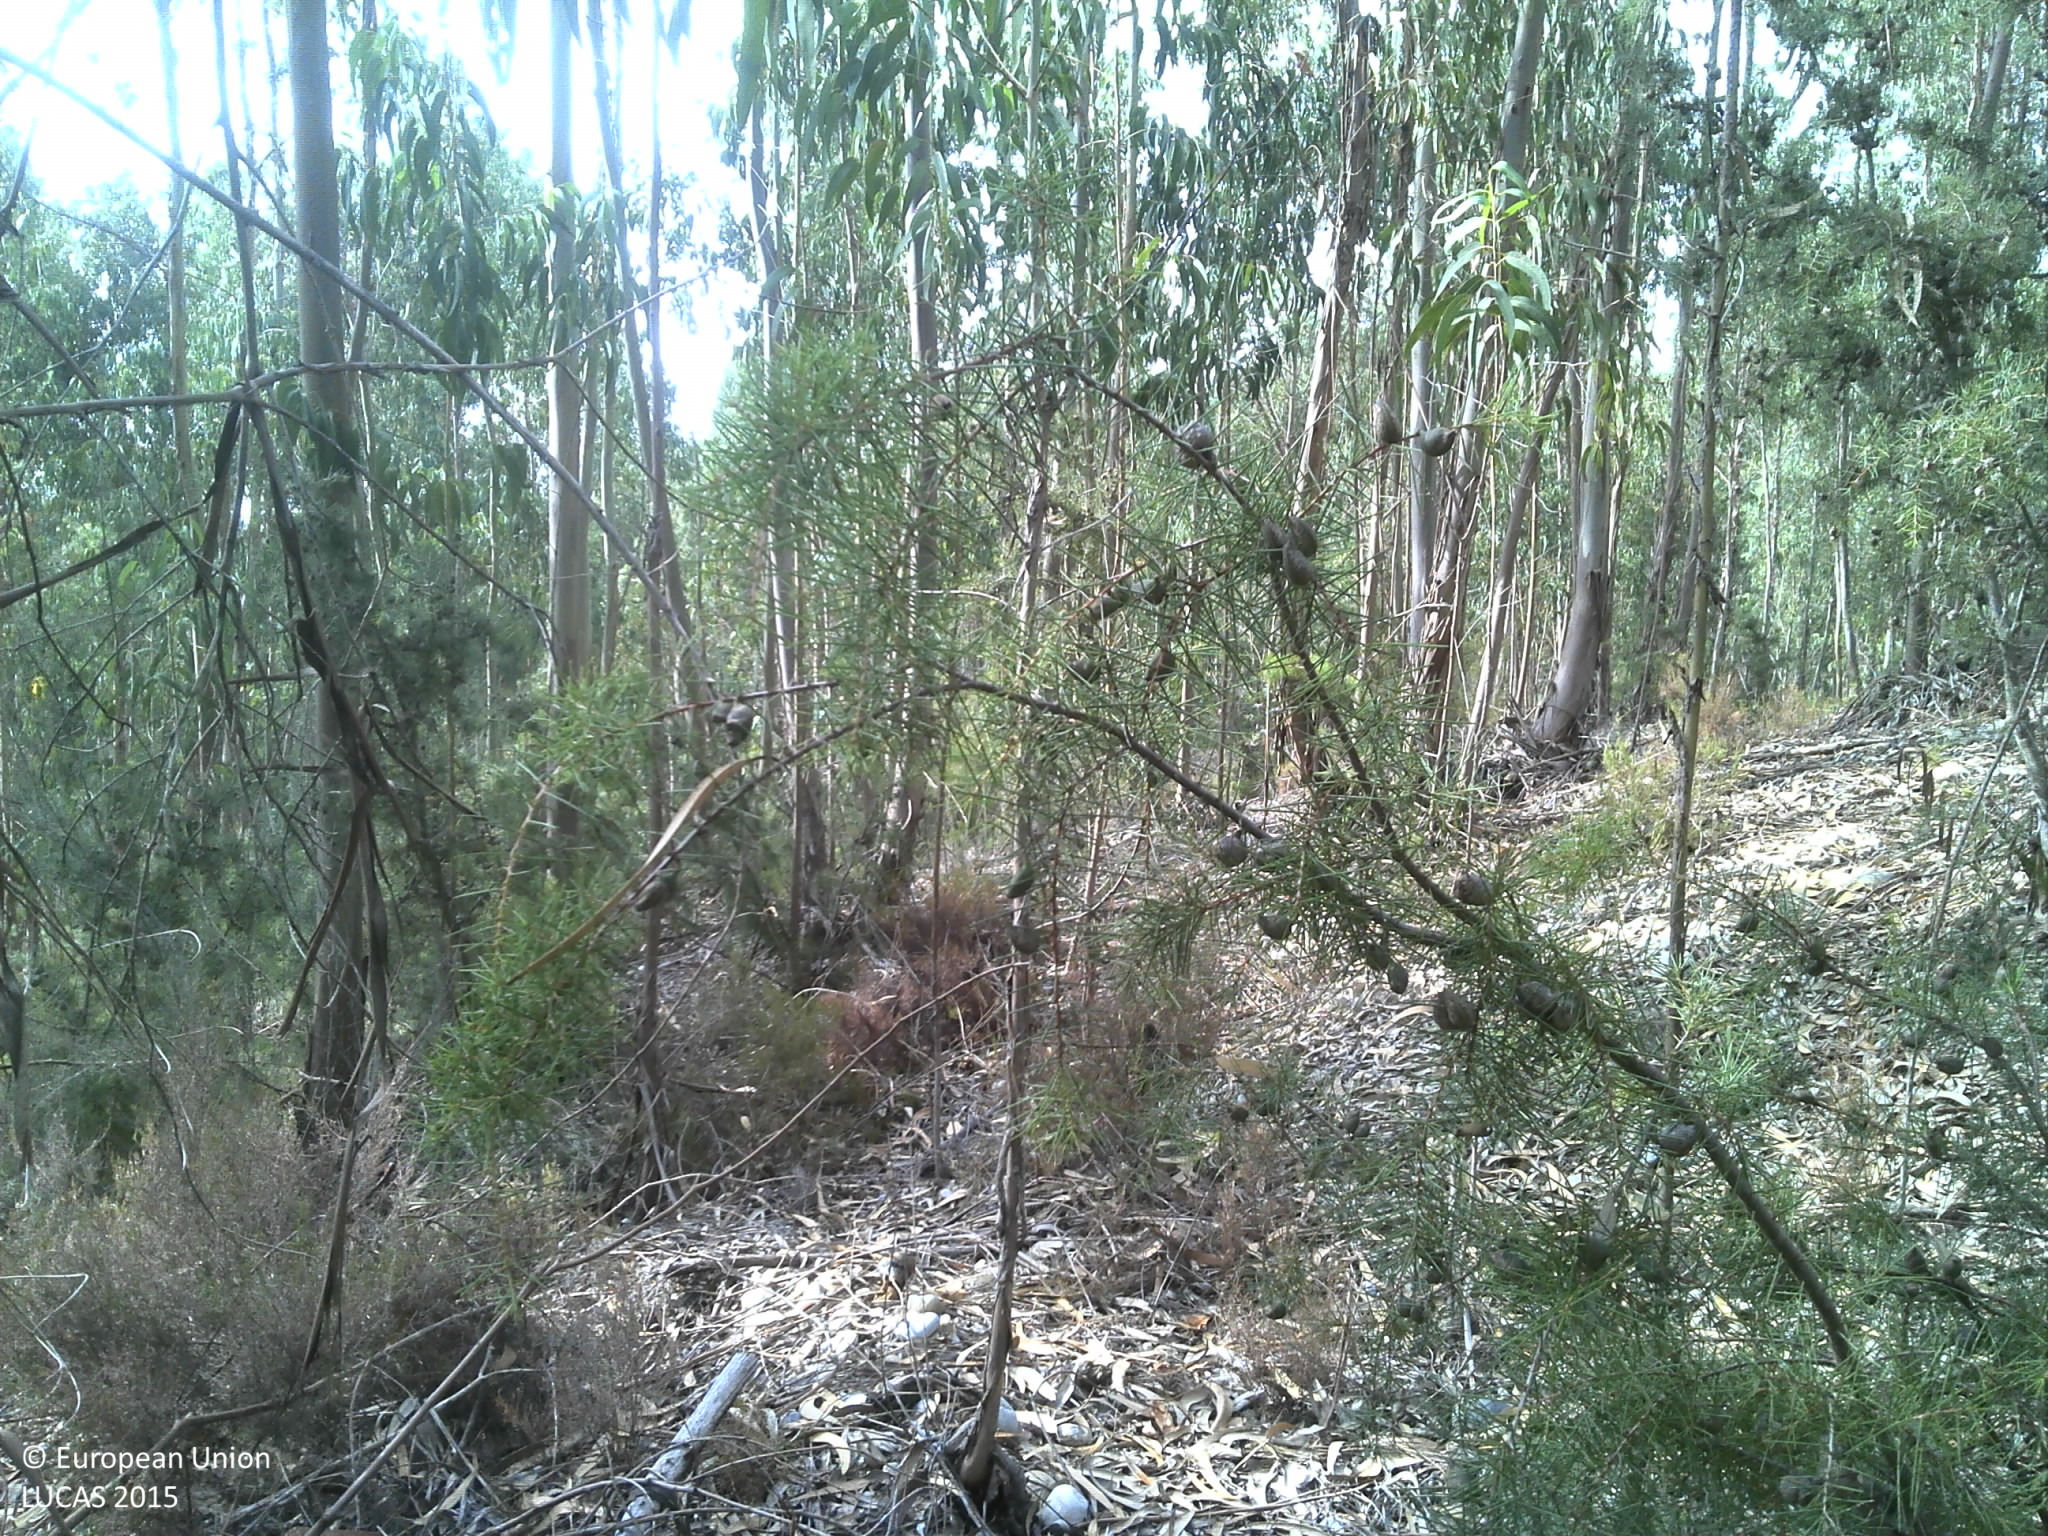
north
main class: Woodland
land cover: Broadleaved woodland
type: exotic forest
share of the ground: 50 - 75 %
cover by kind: broadleaved forest trees 70 %, shrubs 15 %, unconsolidated bare surface 15 %
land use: Forestry
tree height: > 5 m
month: June
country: PT
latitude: 39.3709
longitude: -8.2524
